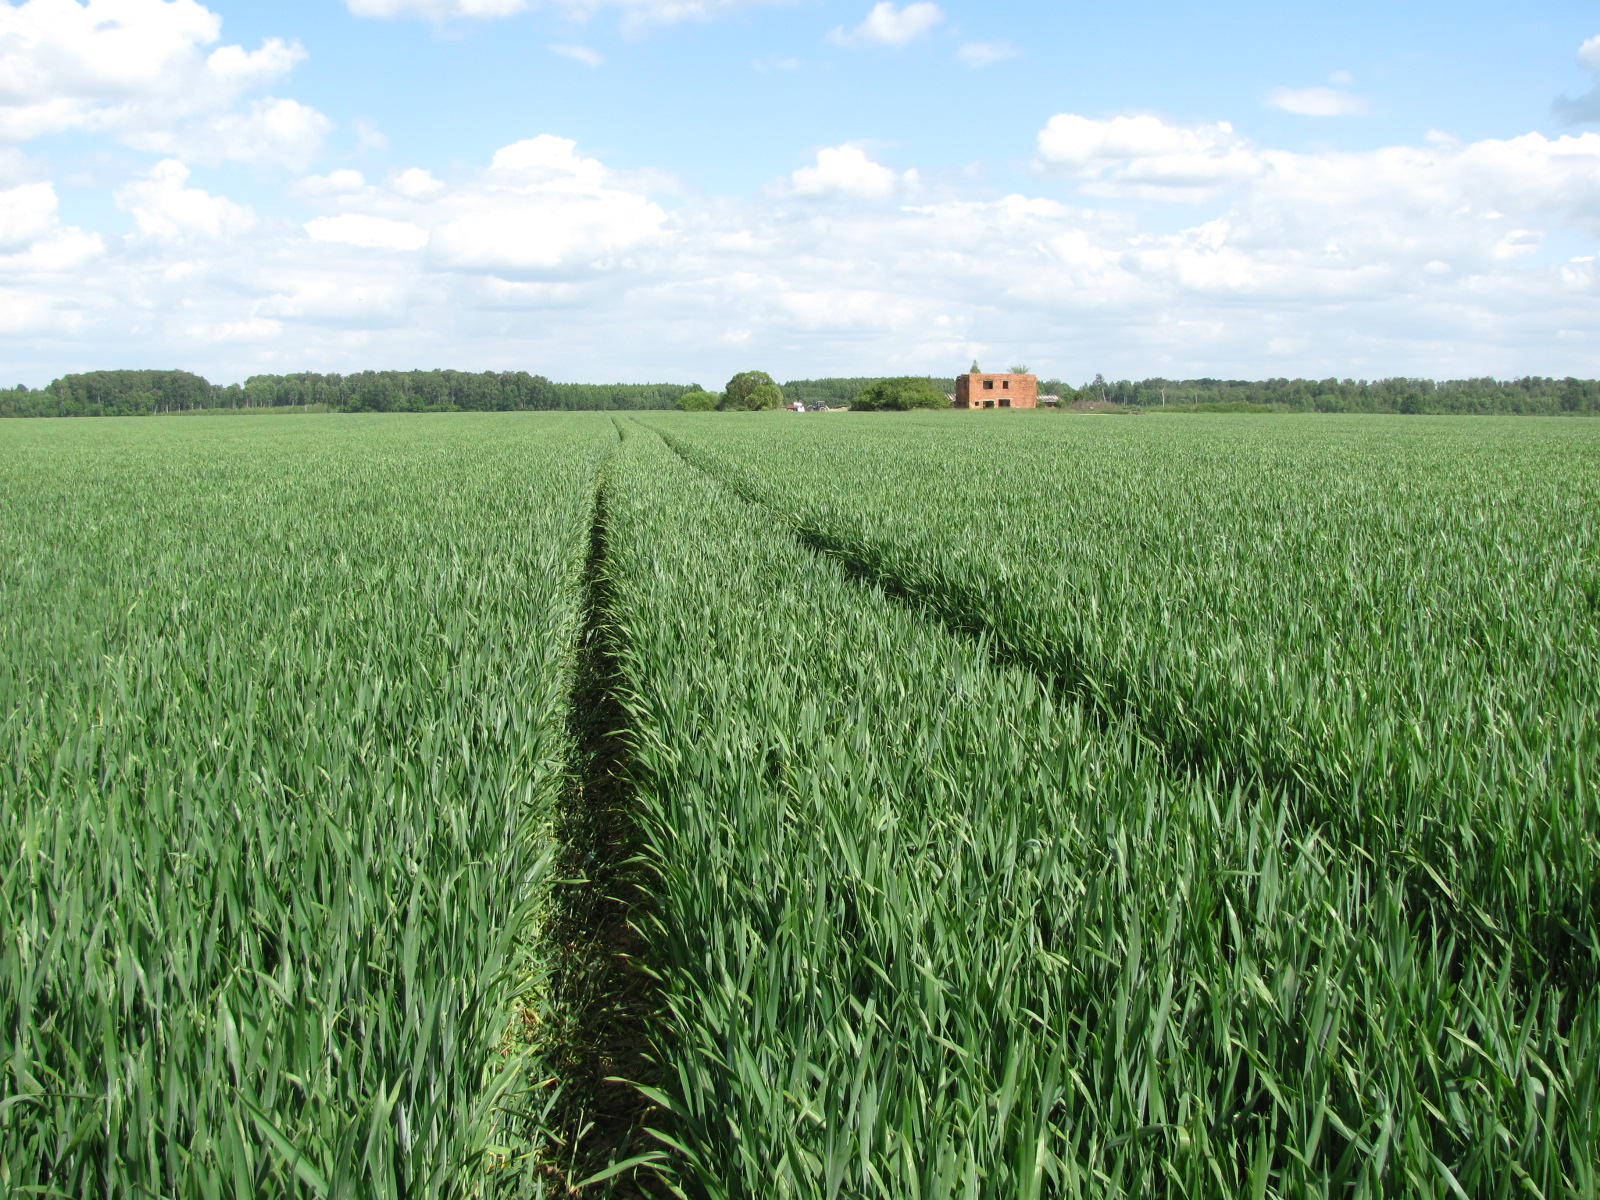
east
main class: Cropland
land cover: Common wheat
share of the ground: > 75 %
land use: Agriculture (excluding fallow land and kitchen gardens)
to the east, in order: Common wheat
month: June
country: LV
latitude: 56.2858
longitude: 24.2259
